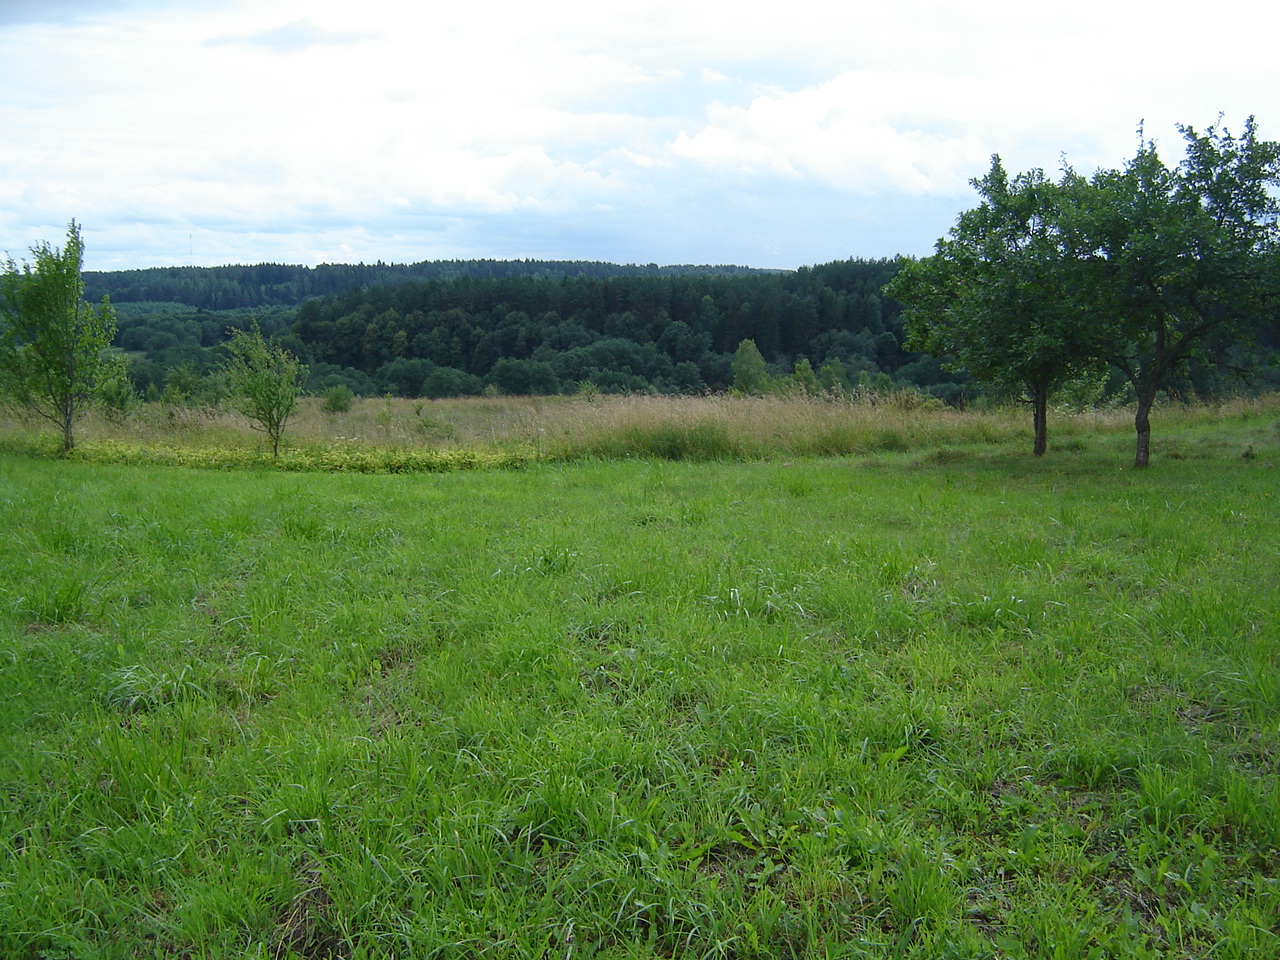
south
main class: Grassland
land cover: Grassland with sparse tree/shrub cover
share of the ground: > 75 %
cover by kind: herbaceous plants 95 %, broadleaved forest trees 5 %
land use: Agriculture (excluding fallow land and kitchen gardens)
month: July
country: LT
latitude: 55.2454
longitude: 25.1375
